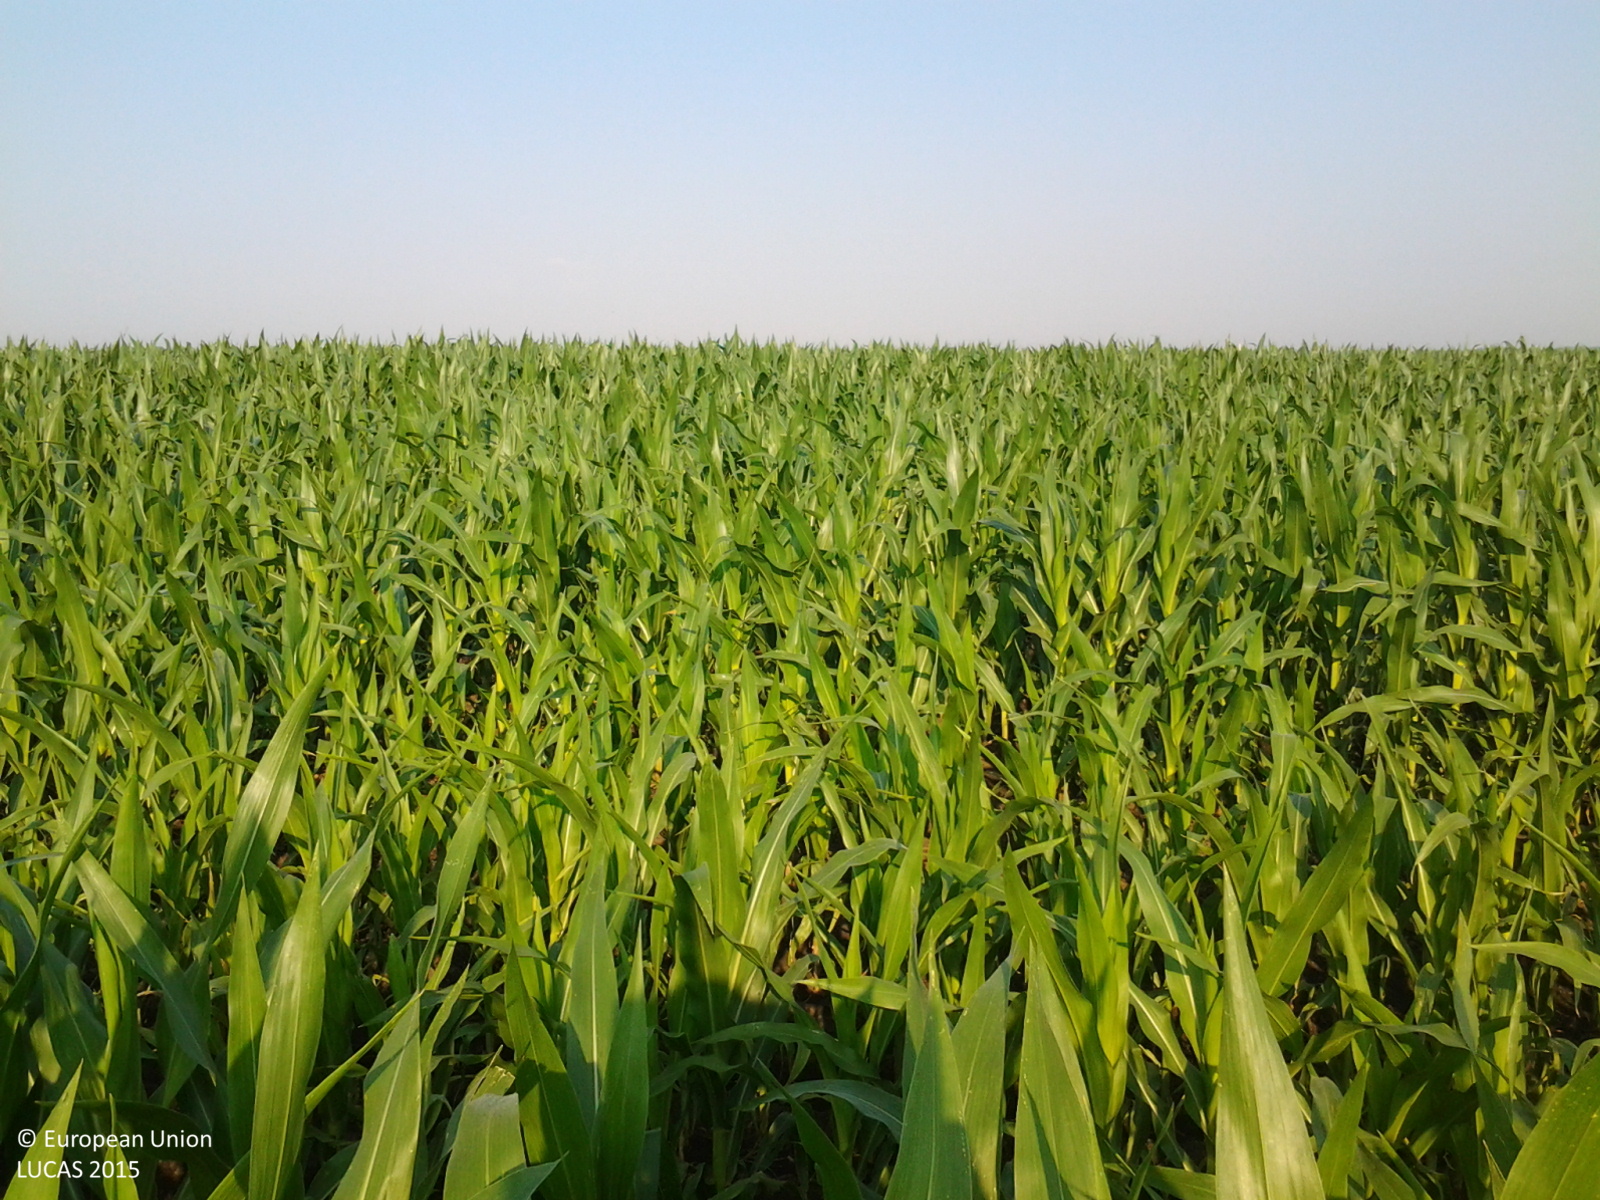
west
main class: Cropland
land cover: Maize
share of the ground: > 75 %
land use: Agriculture (excluding fallow land and kitchen gardens)
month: July
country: HU
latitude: 47.0091
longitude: 20.3528
